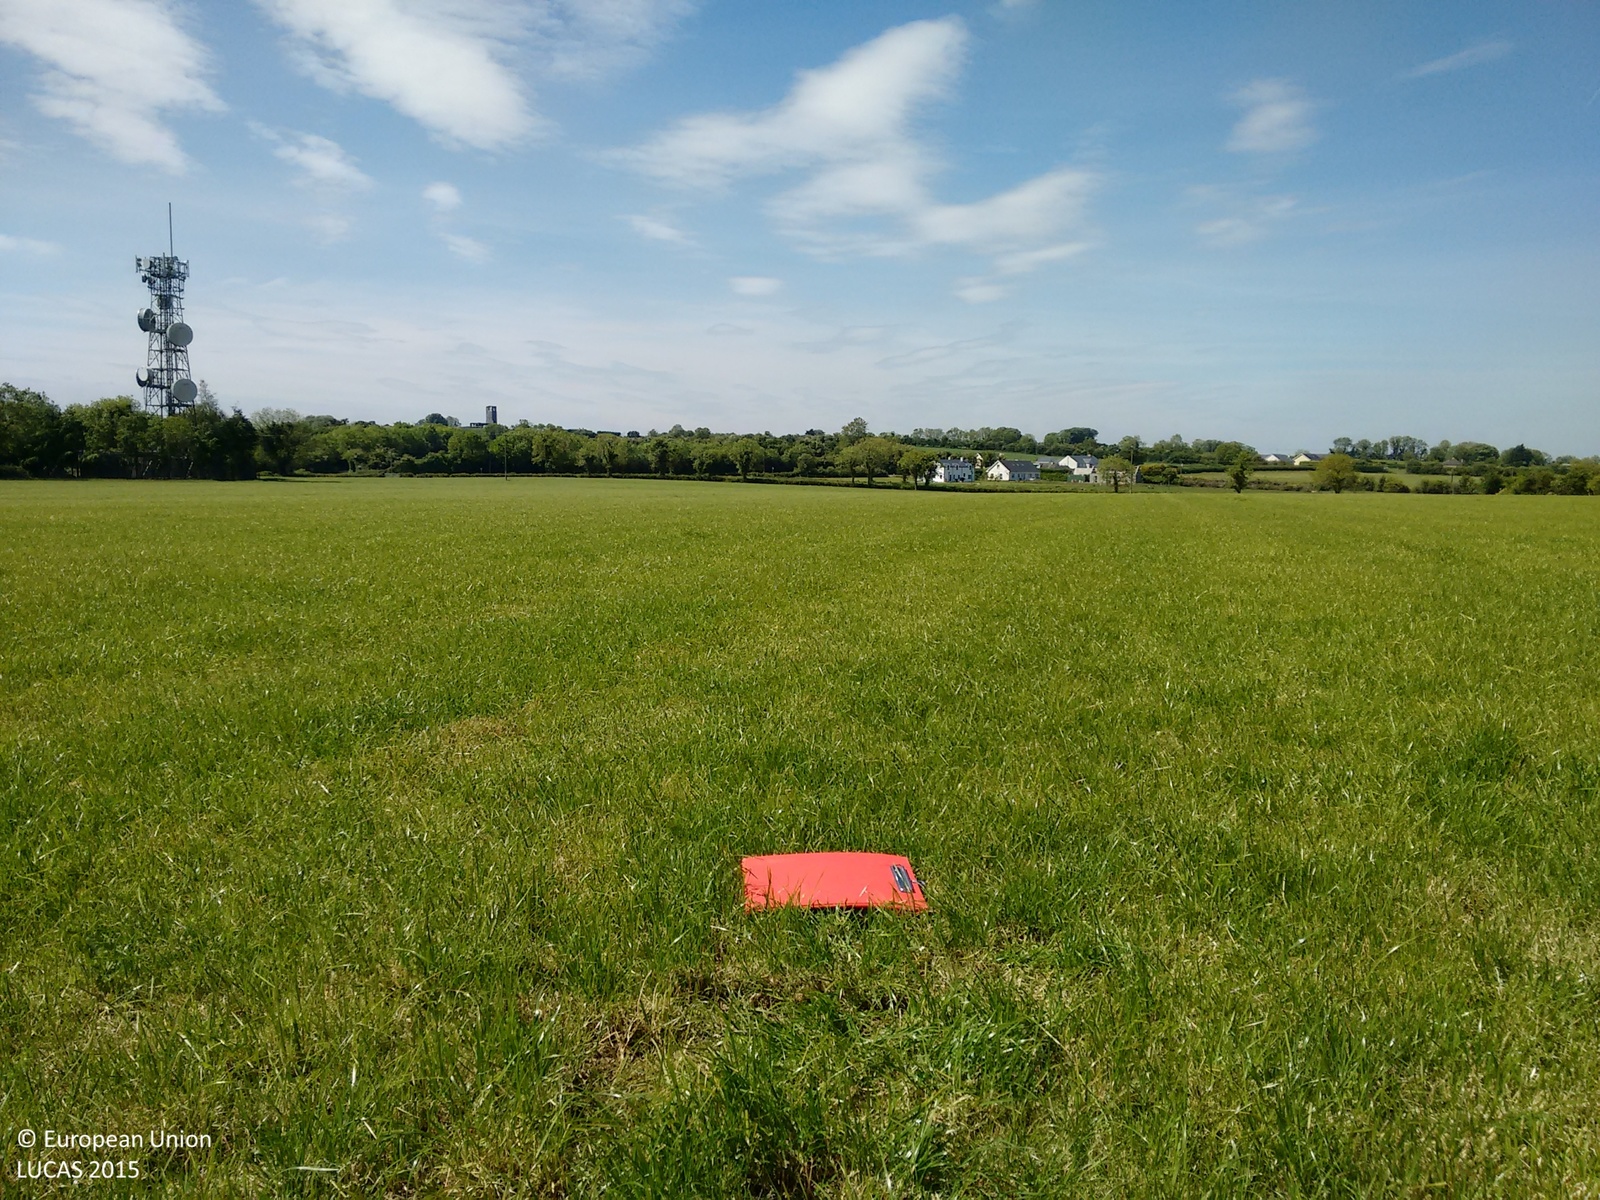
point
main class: Grassland
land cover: Grassland without tree/shrub cover
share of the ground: > 75 %
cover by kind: herbaceous plants 90 %, unconsolidated bare surface 10 %
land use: Agriculture (excluding fallow land and kitchen gardens)
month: June
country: IE
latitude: 53.5932
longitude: -6.5510
